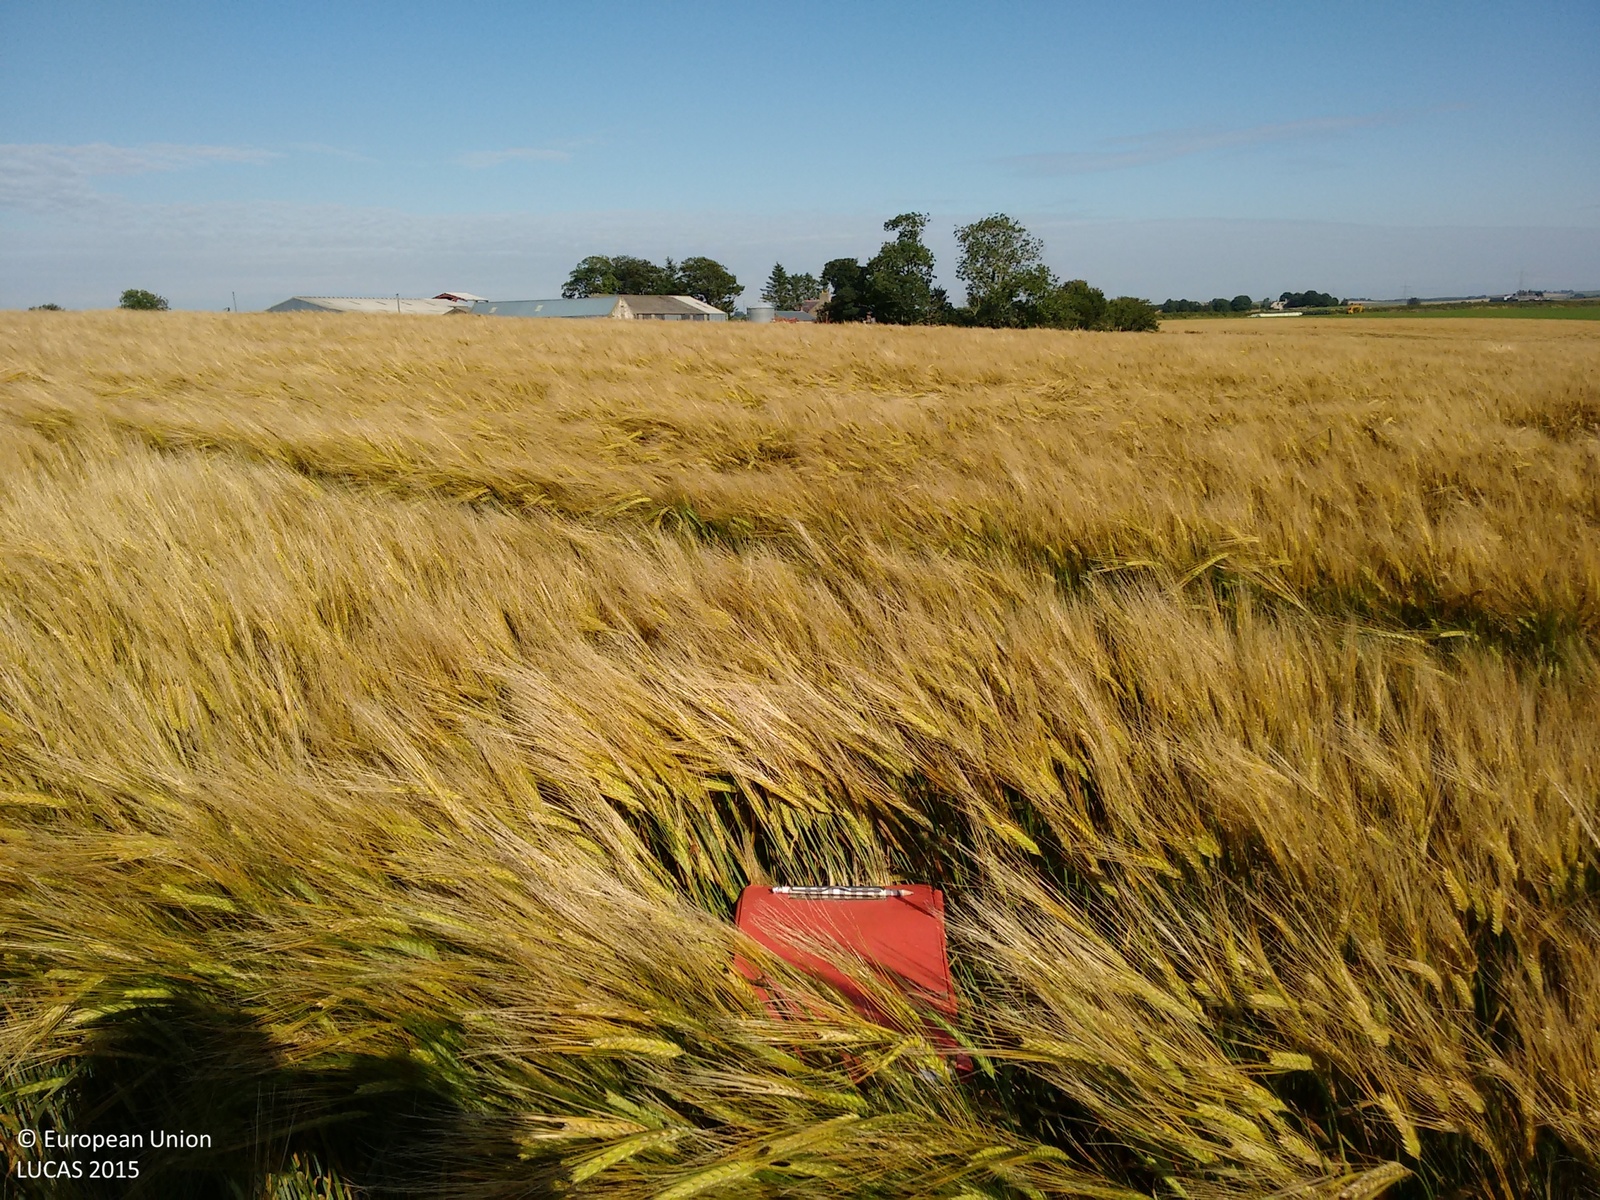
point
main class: Cropland
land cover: Barley
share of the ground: > 75 %
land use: Agriculture (excluding fallow land and kitchen gardens)
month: August
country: GB
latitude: 57.5076
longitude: -2.2836
